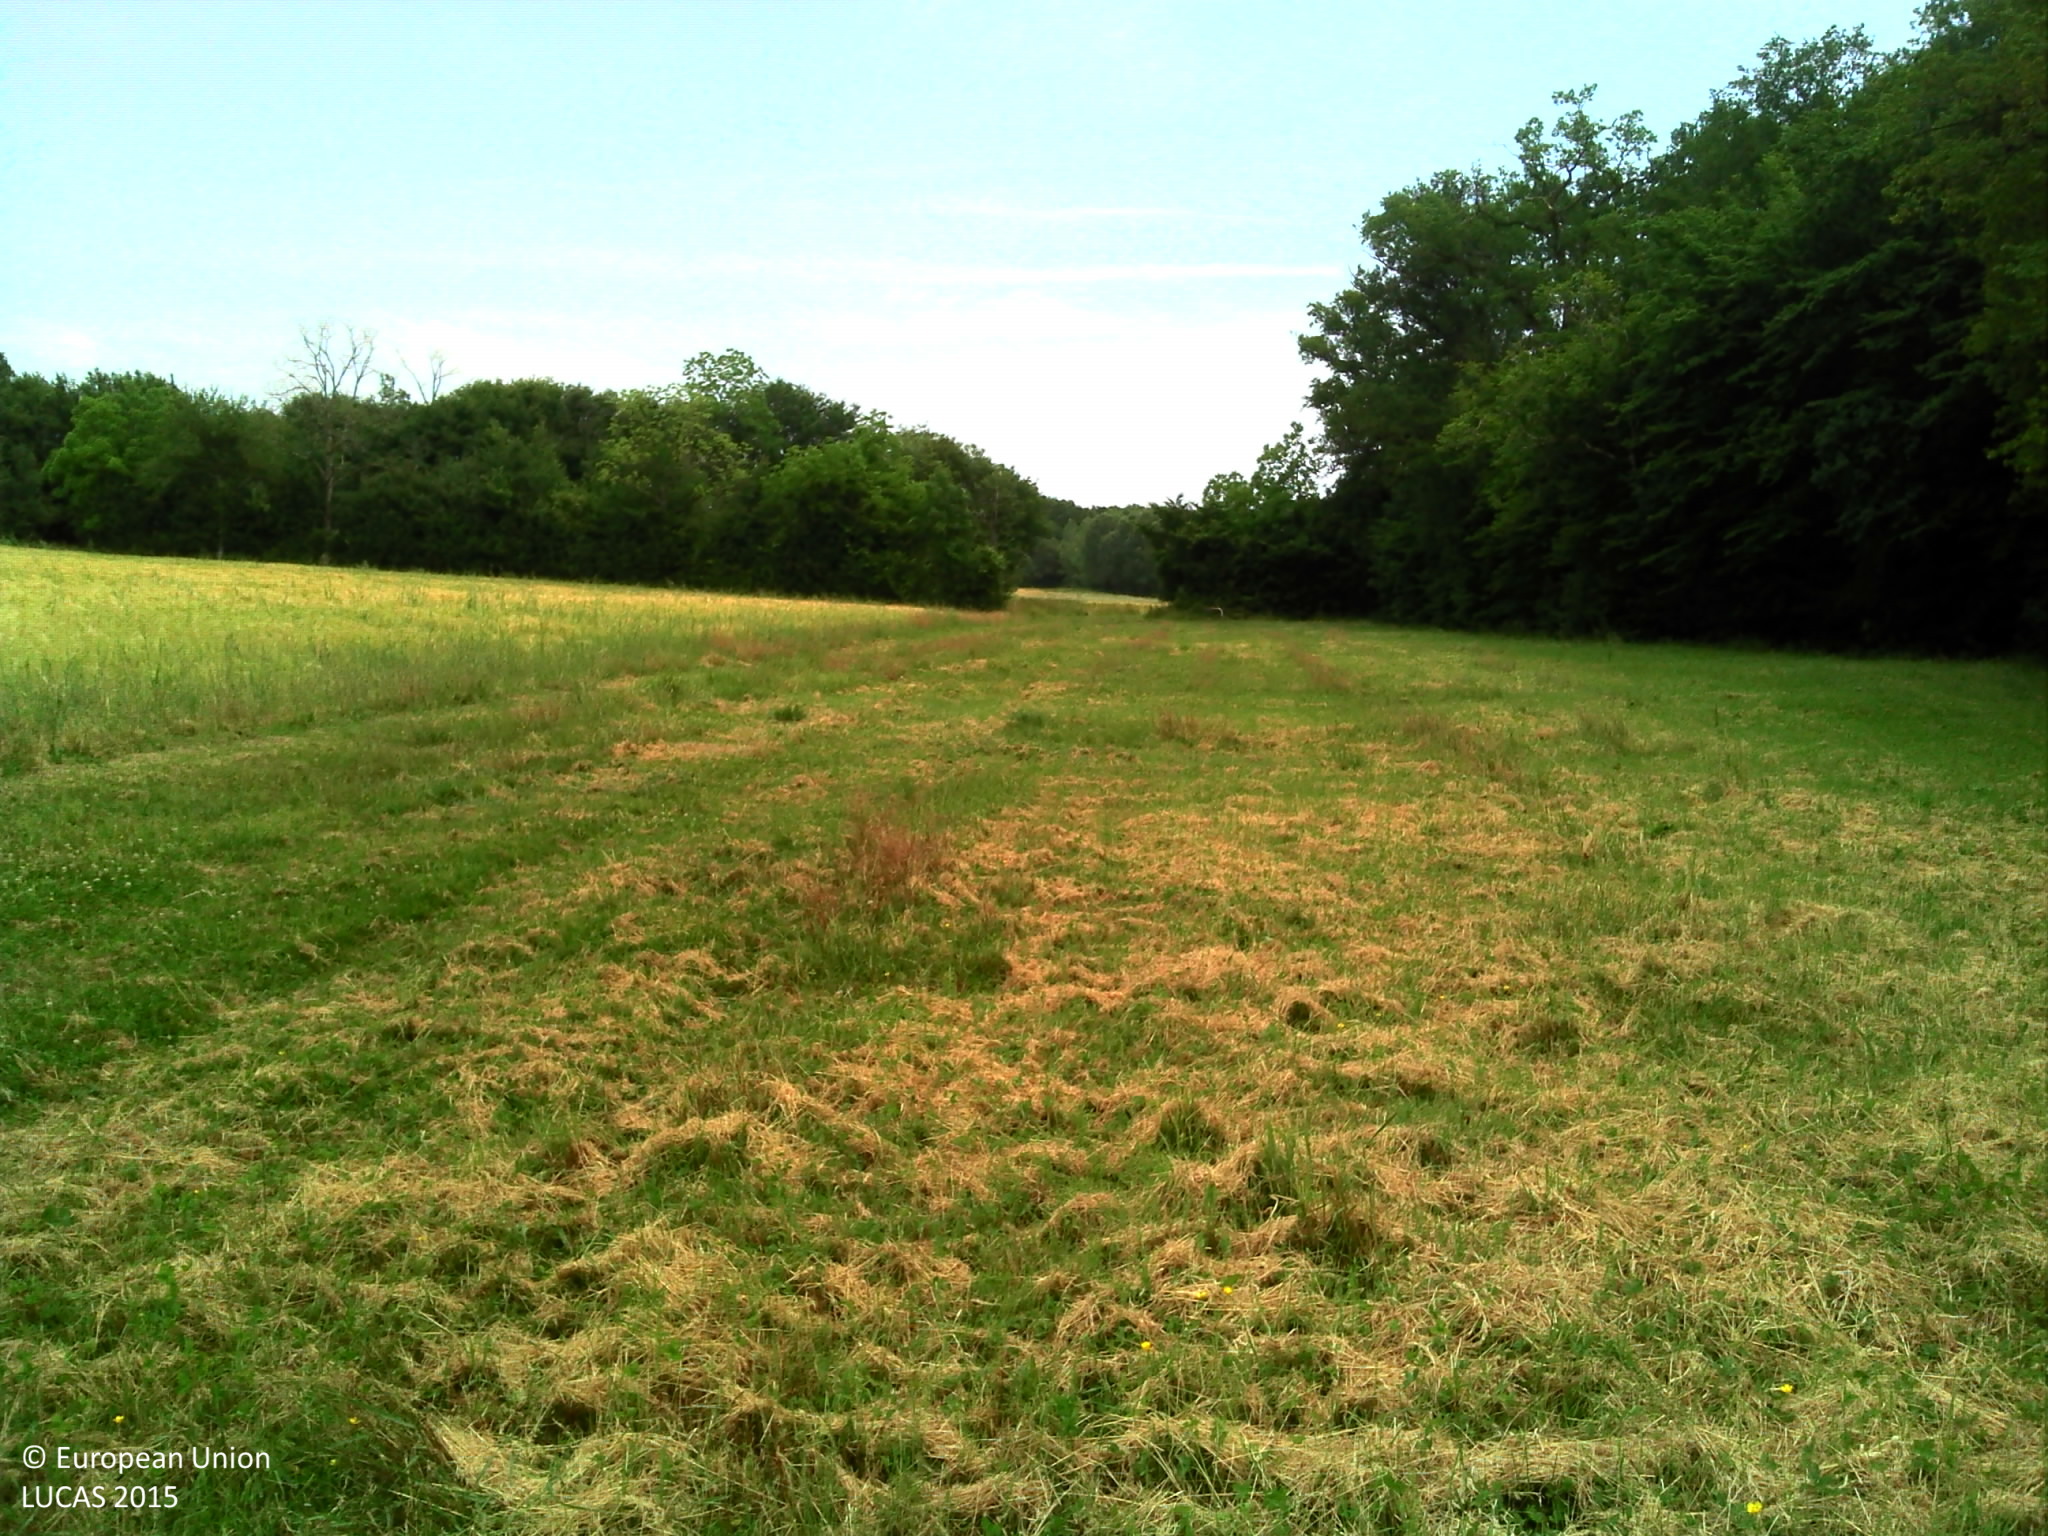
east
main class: Grassland
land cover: Grassland without tree/shrub cover
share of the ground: > 75 %
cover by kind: herbaceous plants 100 %
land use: Agriculture (excluding fallow land and kitchen gardens)
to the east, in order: Grassland without tree/shrub cover; Tracks; Grassland without tree/shrub cover; Barley
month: June
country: FR
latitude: 46.8387
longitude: 2.6389
